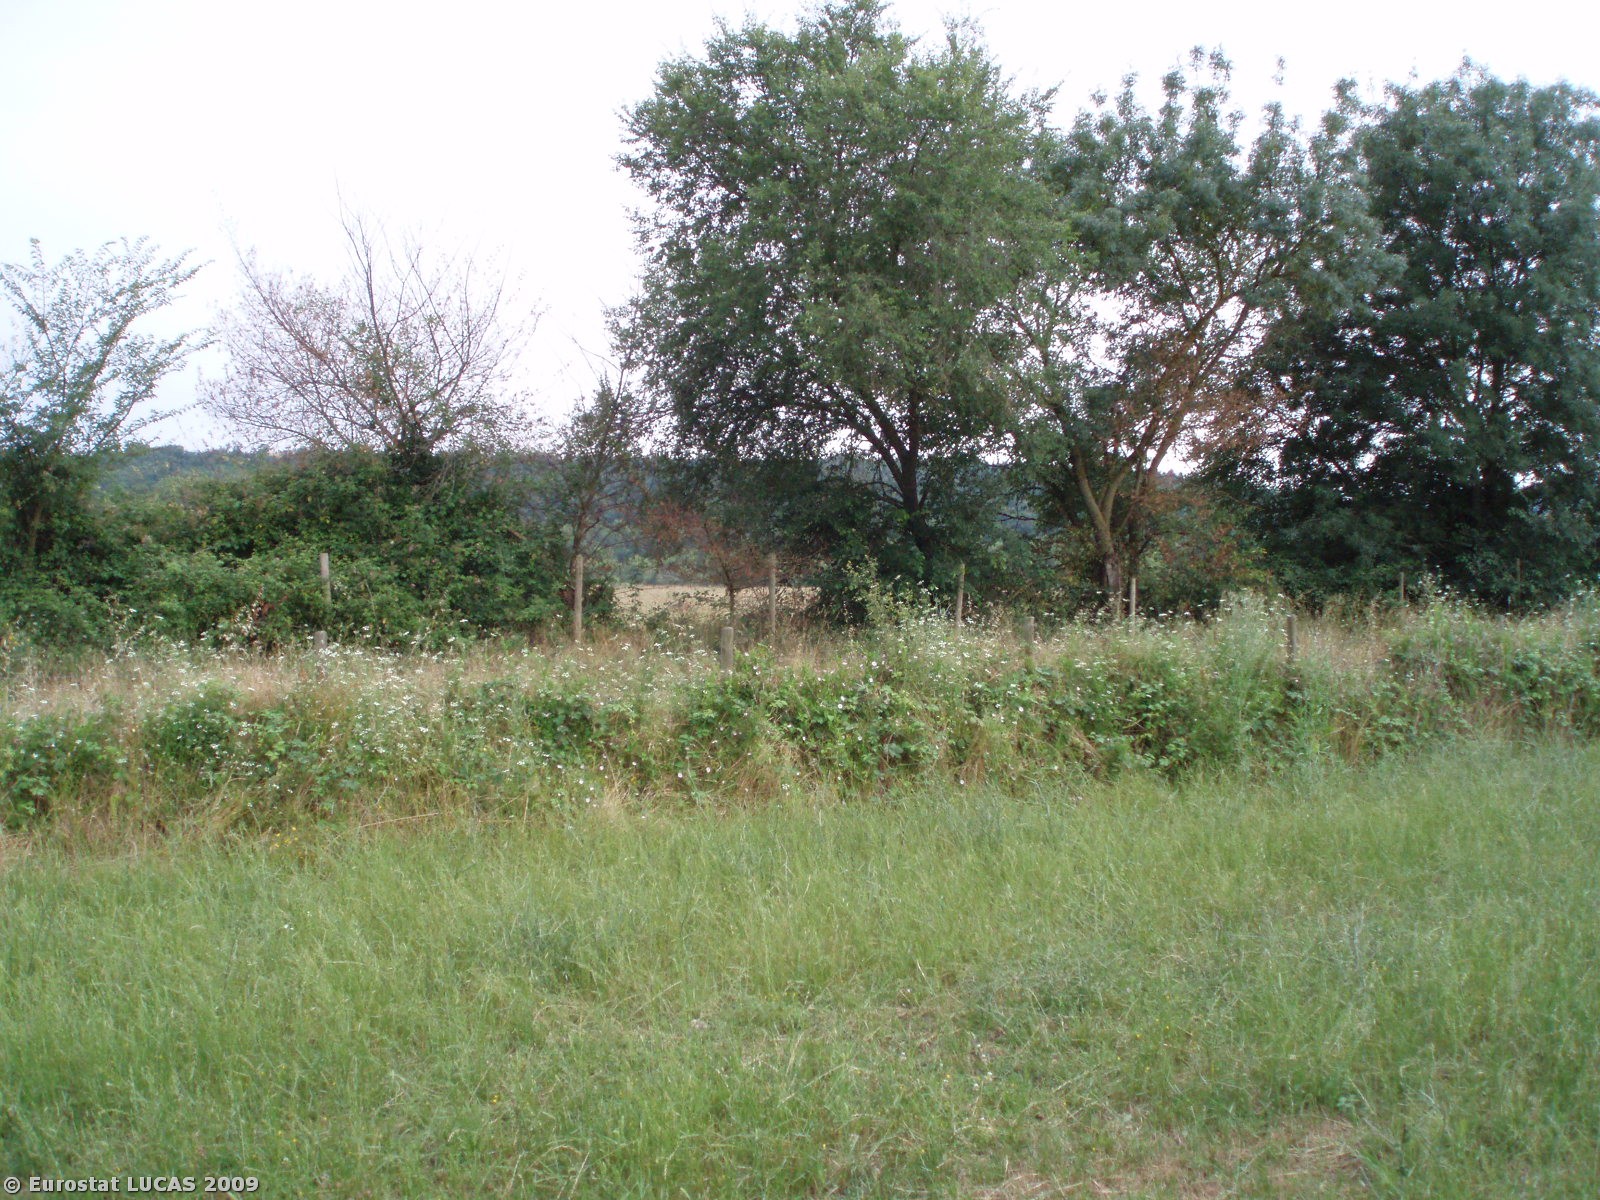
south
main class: Grassland
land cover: Grassland without tree/shrub cover
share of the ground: > 75 %
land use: Agriculture (excluding fallow land and kitchen gardens)
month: June
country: IT
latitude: 42.6415
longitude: 11.5924
